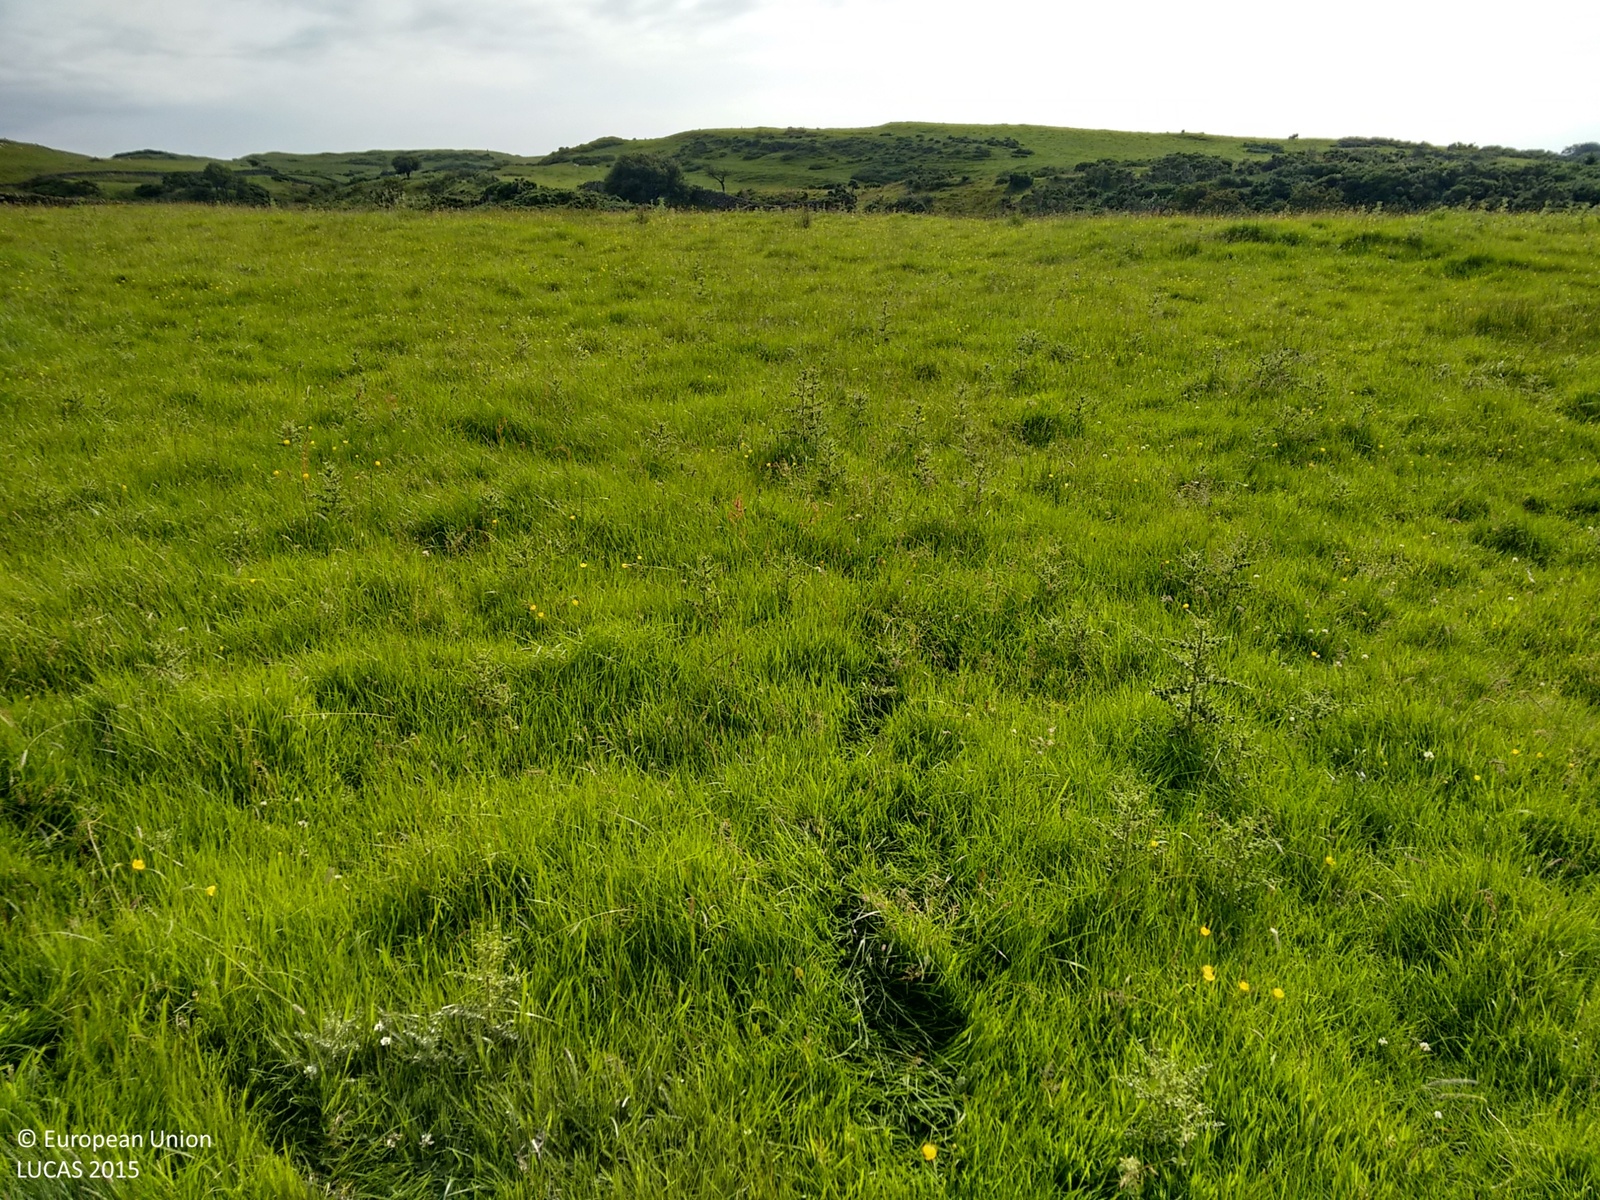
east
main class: Grassland
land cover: Grassland without tree/shrub cover
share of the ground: > 75 %
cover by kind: herbaceous plants 100 %
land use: Agriculture (excluding fallow land and kitchen gardens)
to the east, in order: Grassland without tree/shrub cover; Dry stone walls; Shrubland without tree cover; Grassland without tree/shrub cover
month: July
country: GB
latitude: 54.8133
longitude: -3.9868
